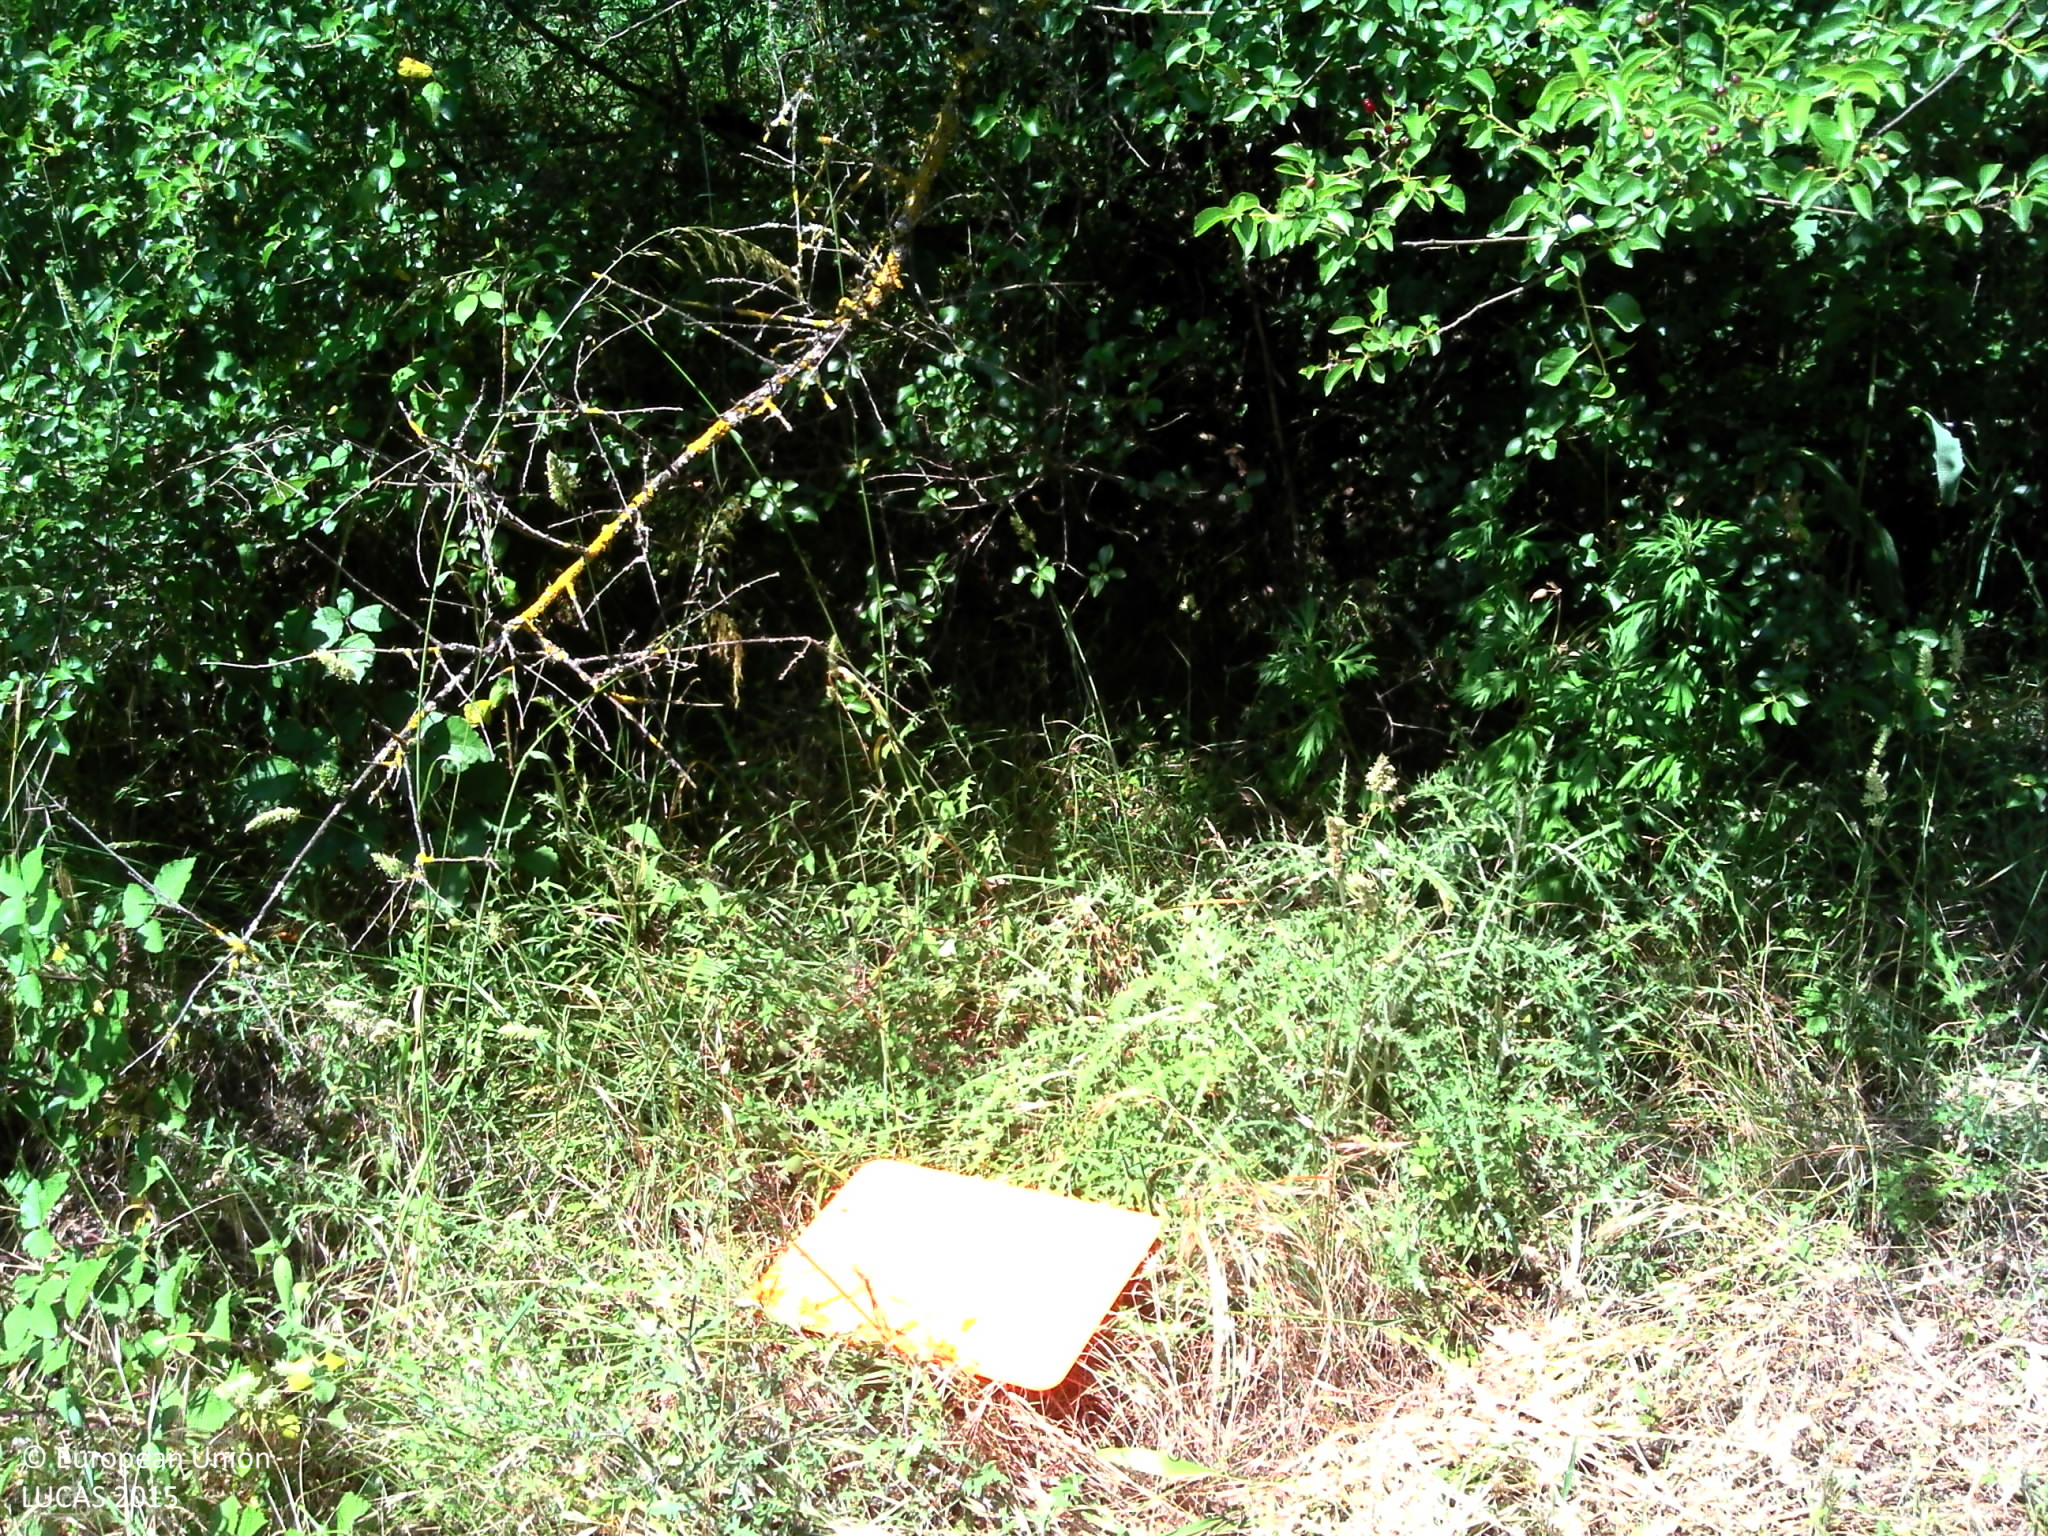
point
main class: Woodland
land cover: Broadleaved woodland
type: thermophilous deciduous forest
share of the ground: > 75 %
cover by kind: broadleaved forest trees 95 %, herbaceous plants 5 %
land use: Semi-natural and natural areas not in use
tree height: > 5 m
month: May
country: FR
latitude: 45.0029
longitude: 4.9183
